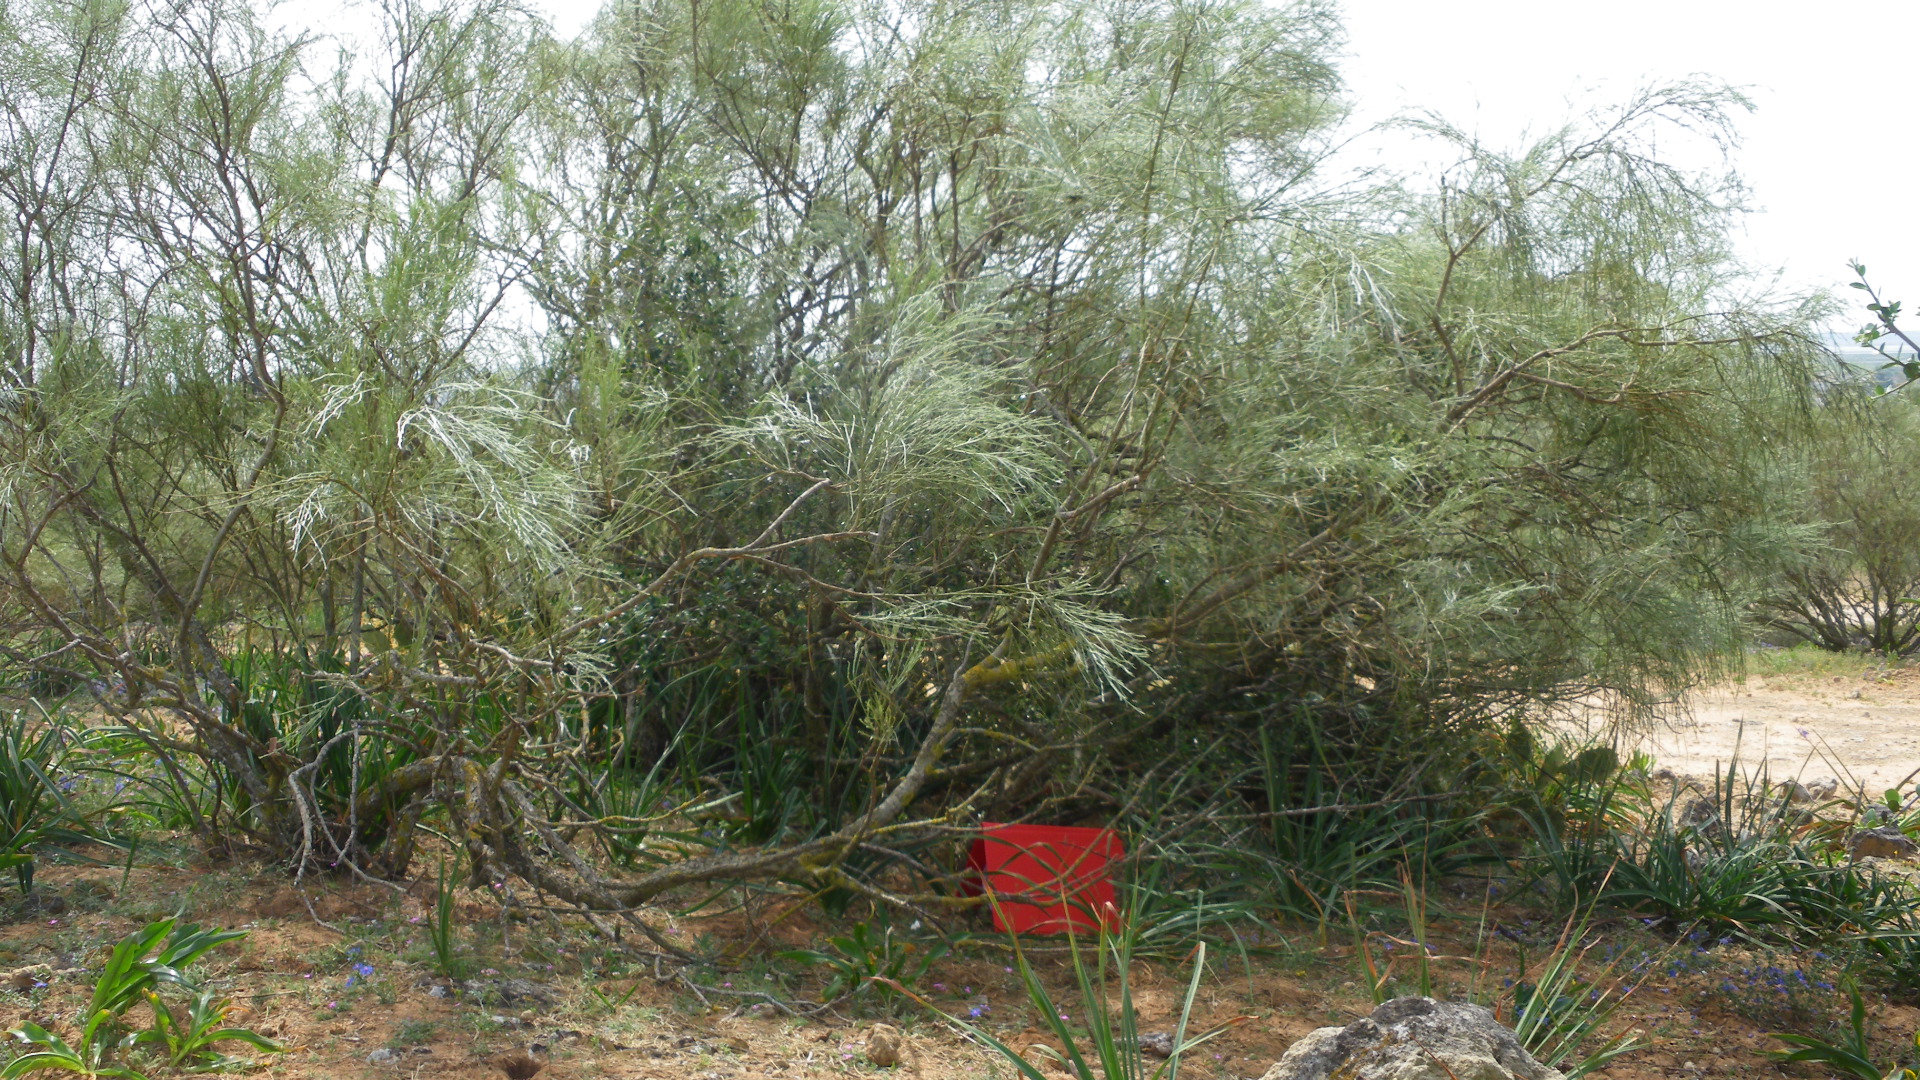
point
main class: Shrubland
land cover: Shrubland without tree cover
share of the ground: 25 - 50 %
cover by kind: shrubs 50 %, consolidated bare surface 30 %, herbaceous plants 20 %
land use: Semi-natural and natural areas not in use
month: April
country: ES
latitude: 36.6303
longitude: -6.1713
